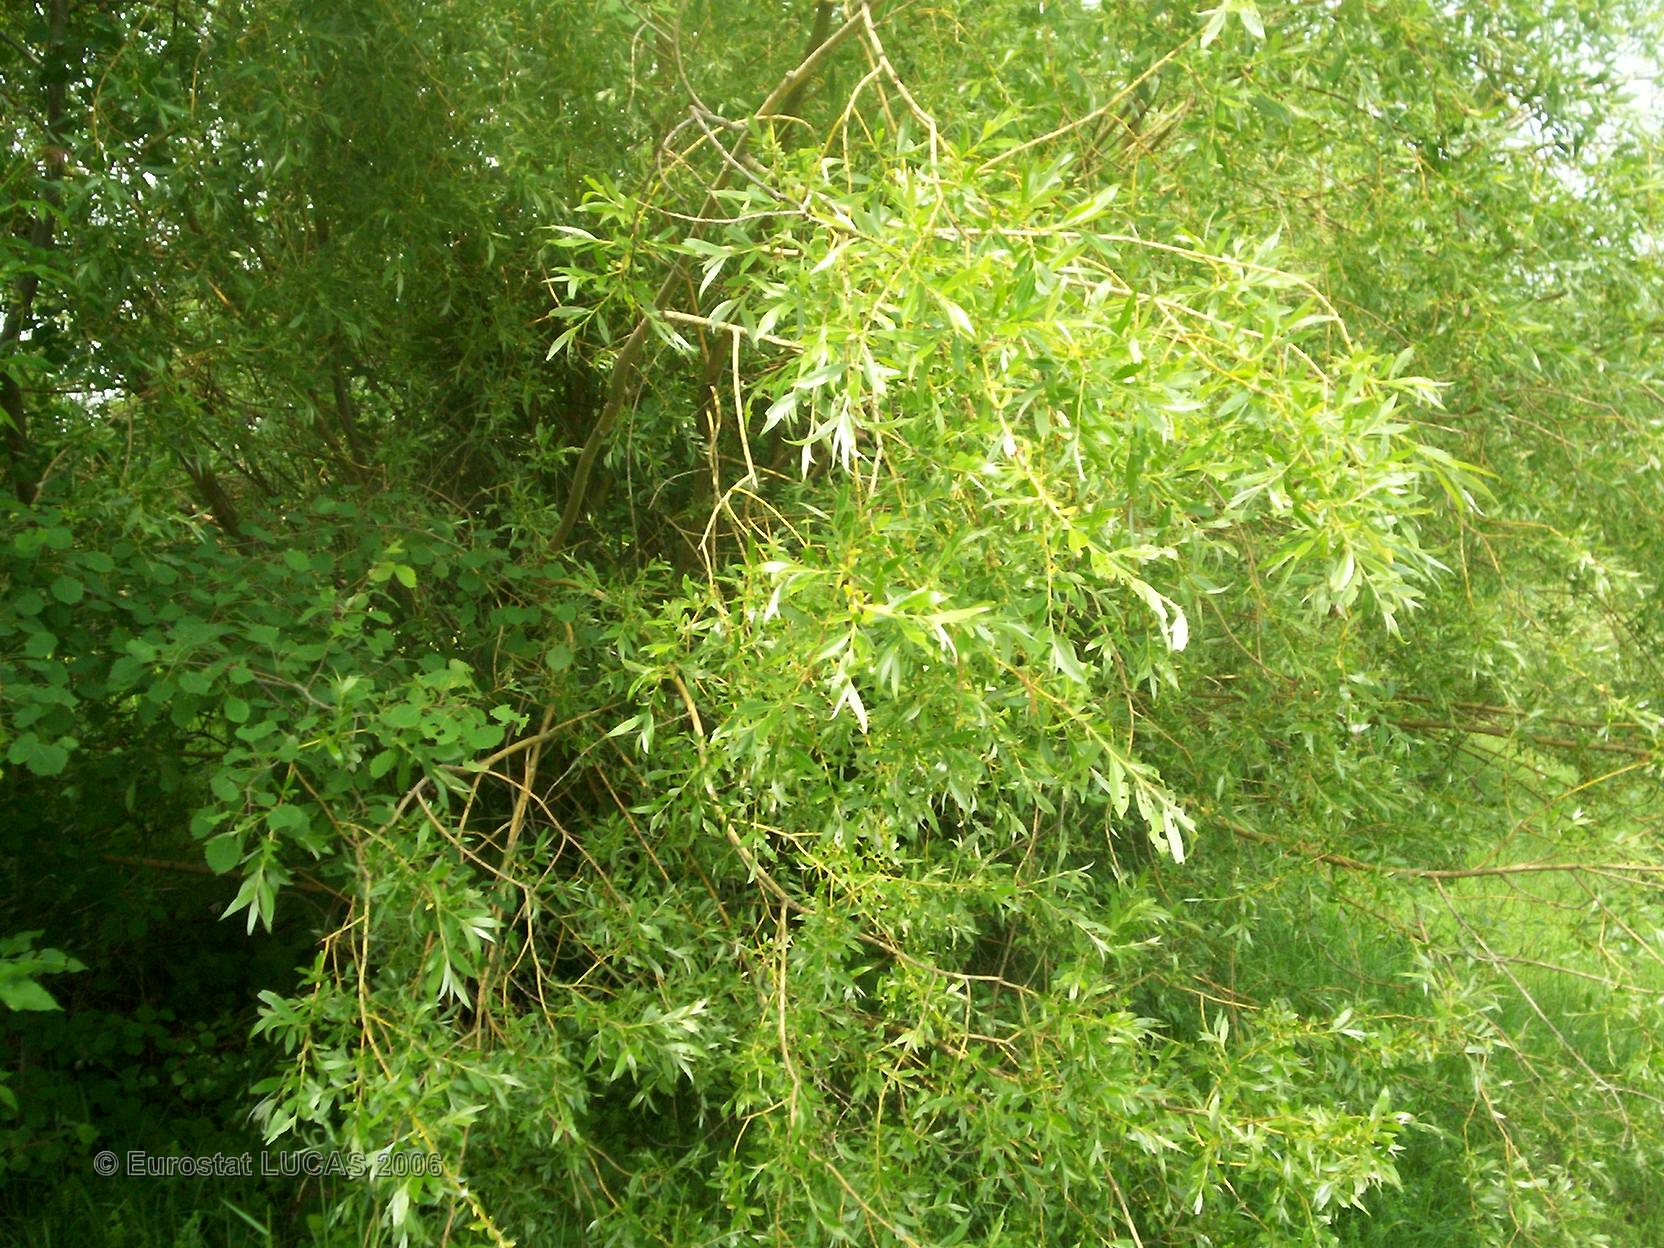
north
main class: Cropland
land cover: Apple fruit
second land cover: Grassland with sparse tree/shrub cover
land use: Kitchen garden
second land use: Residential
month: May
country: FR
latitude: 46.7253
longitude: 4.7020
